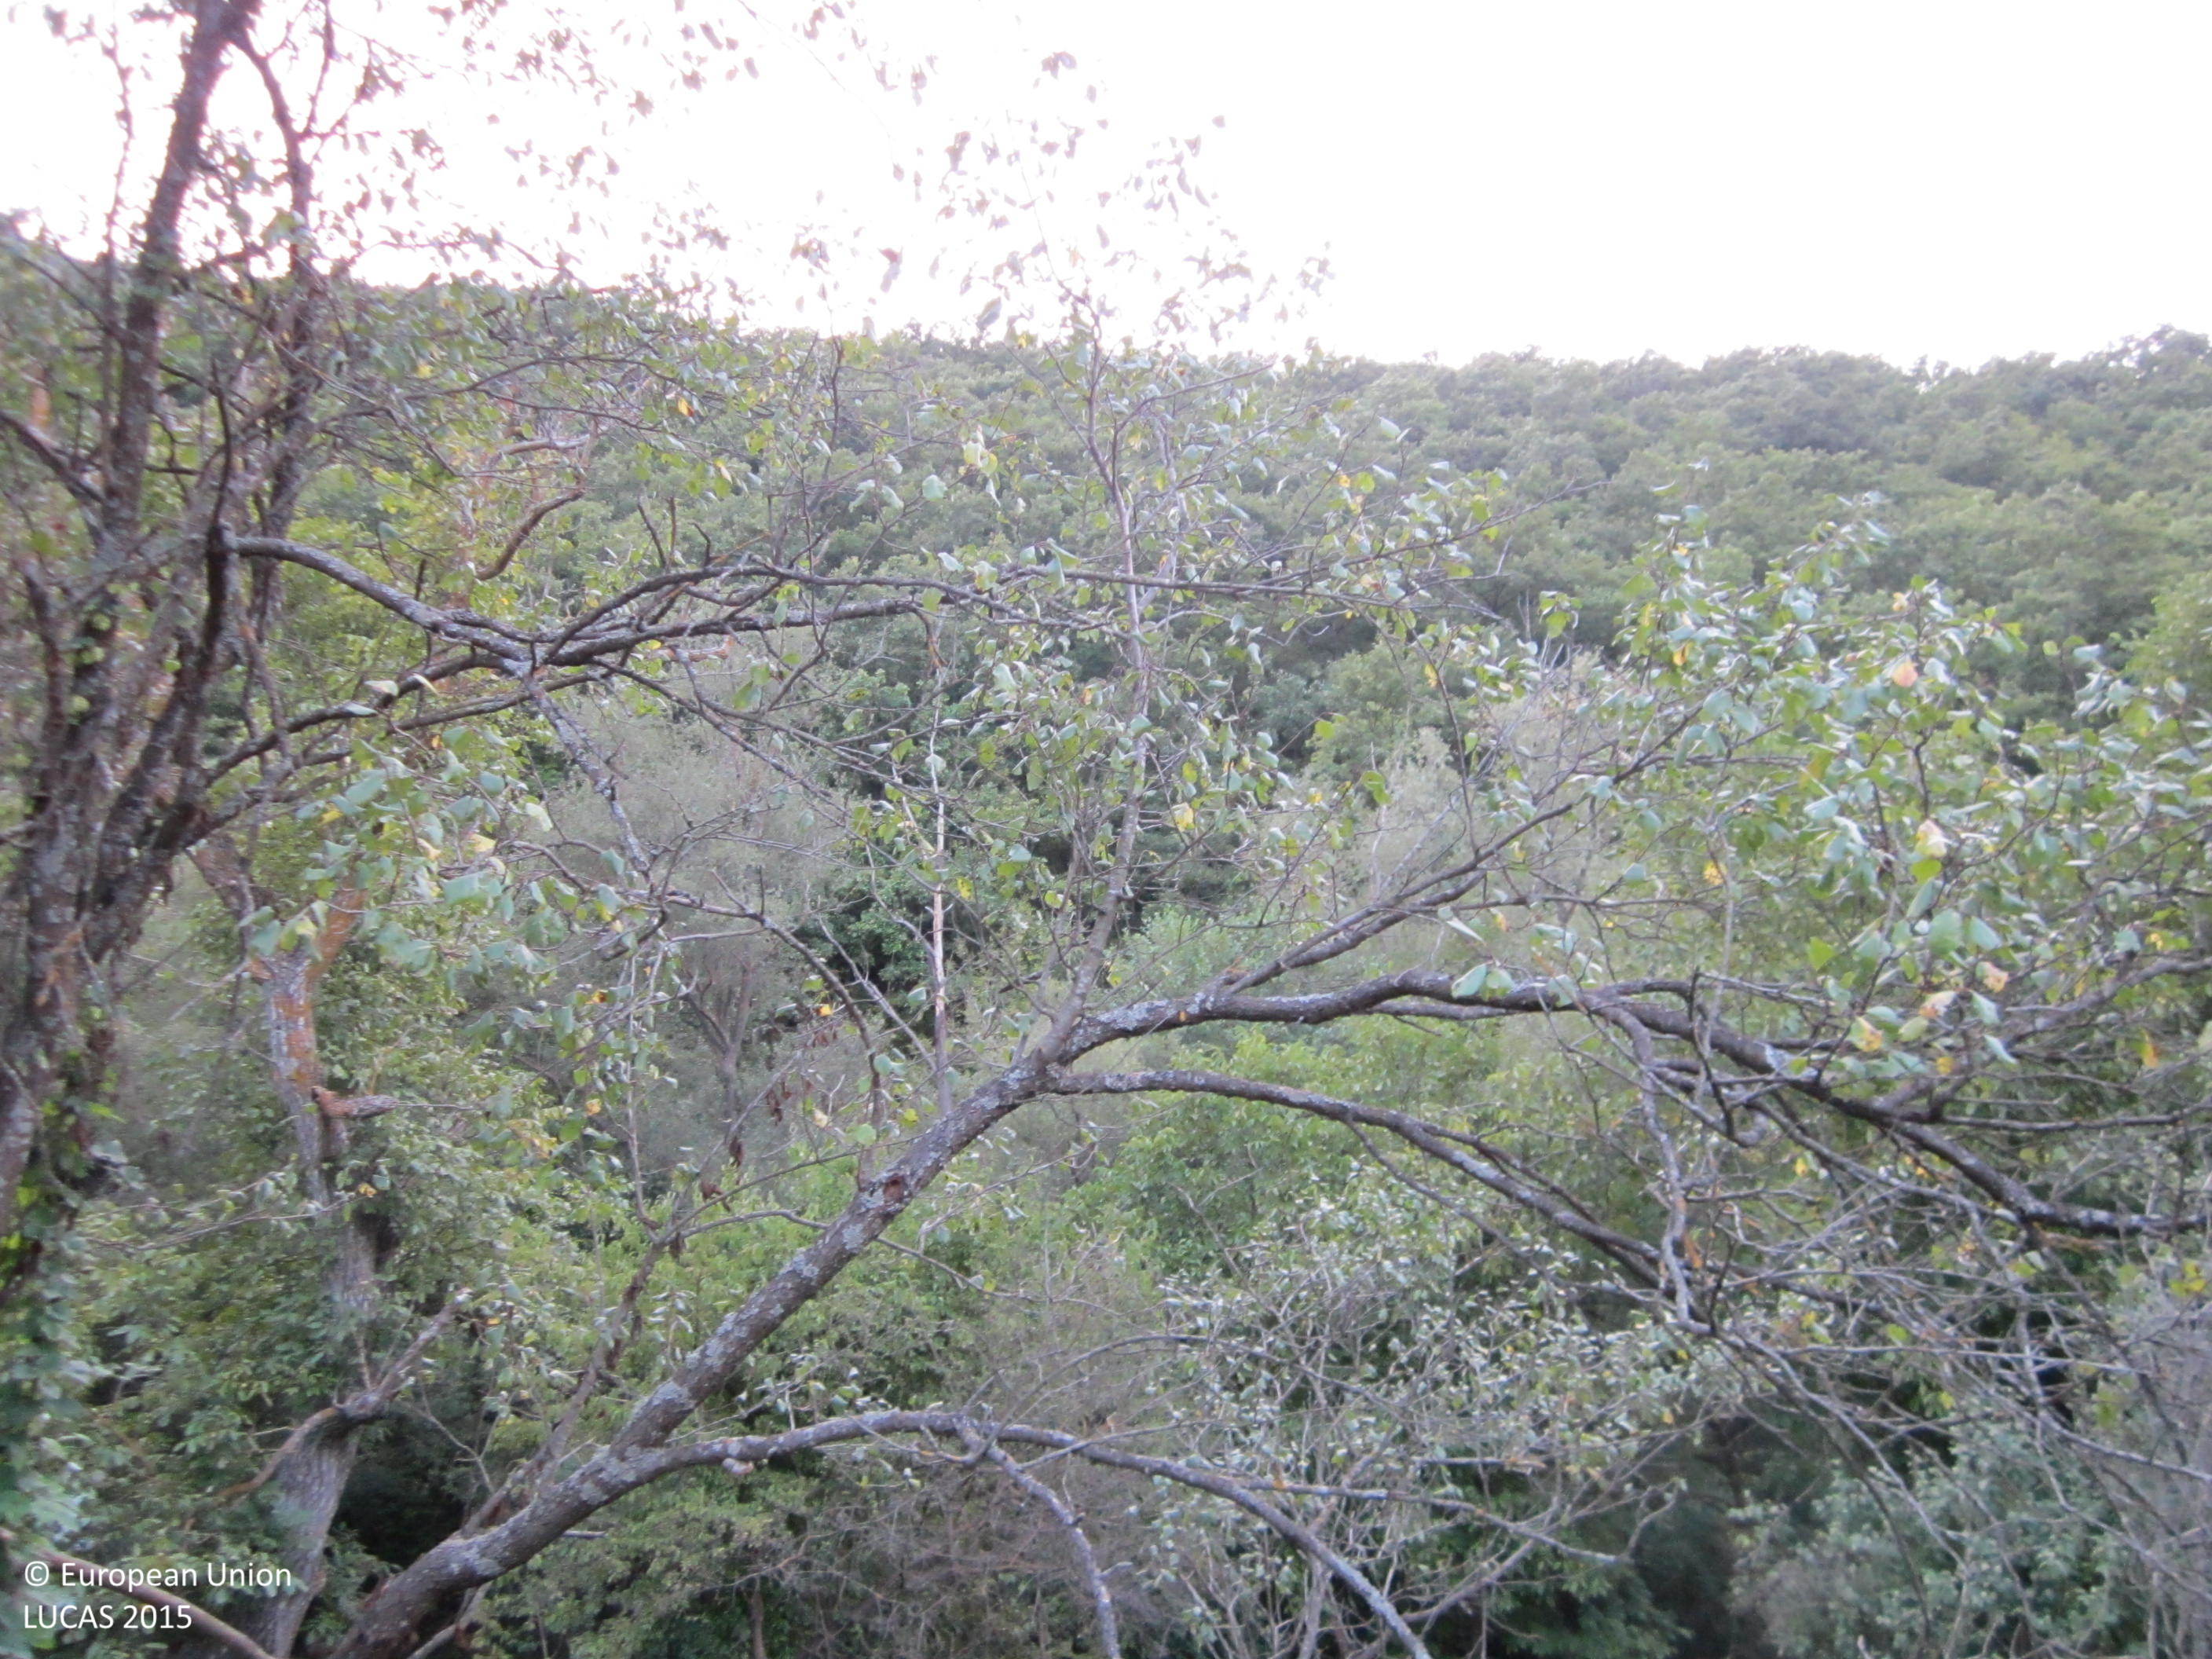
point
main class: Woodland
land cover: Broadleaved woodland
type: mesophytic deciduous forest
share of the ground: > 75 %
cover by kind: broadleaved forest trees 100 %
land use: Forestry
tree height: > 5 m
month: September
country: BG
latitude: 42.8486
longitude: 27.1843
